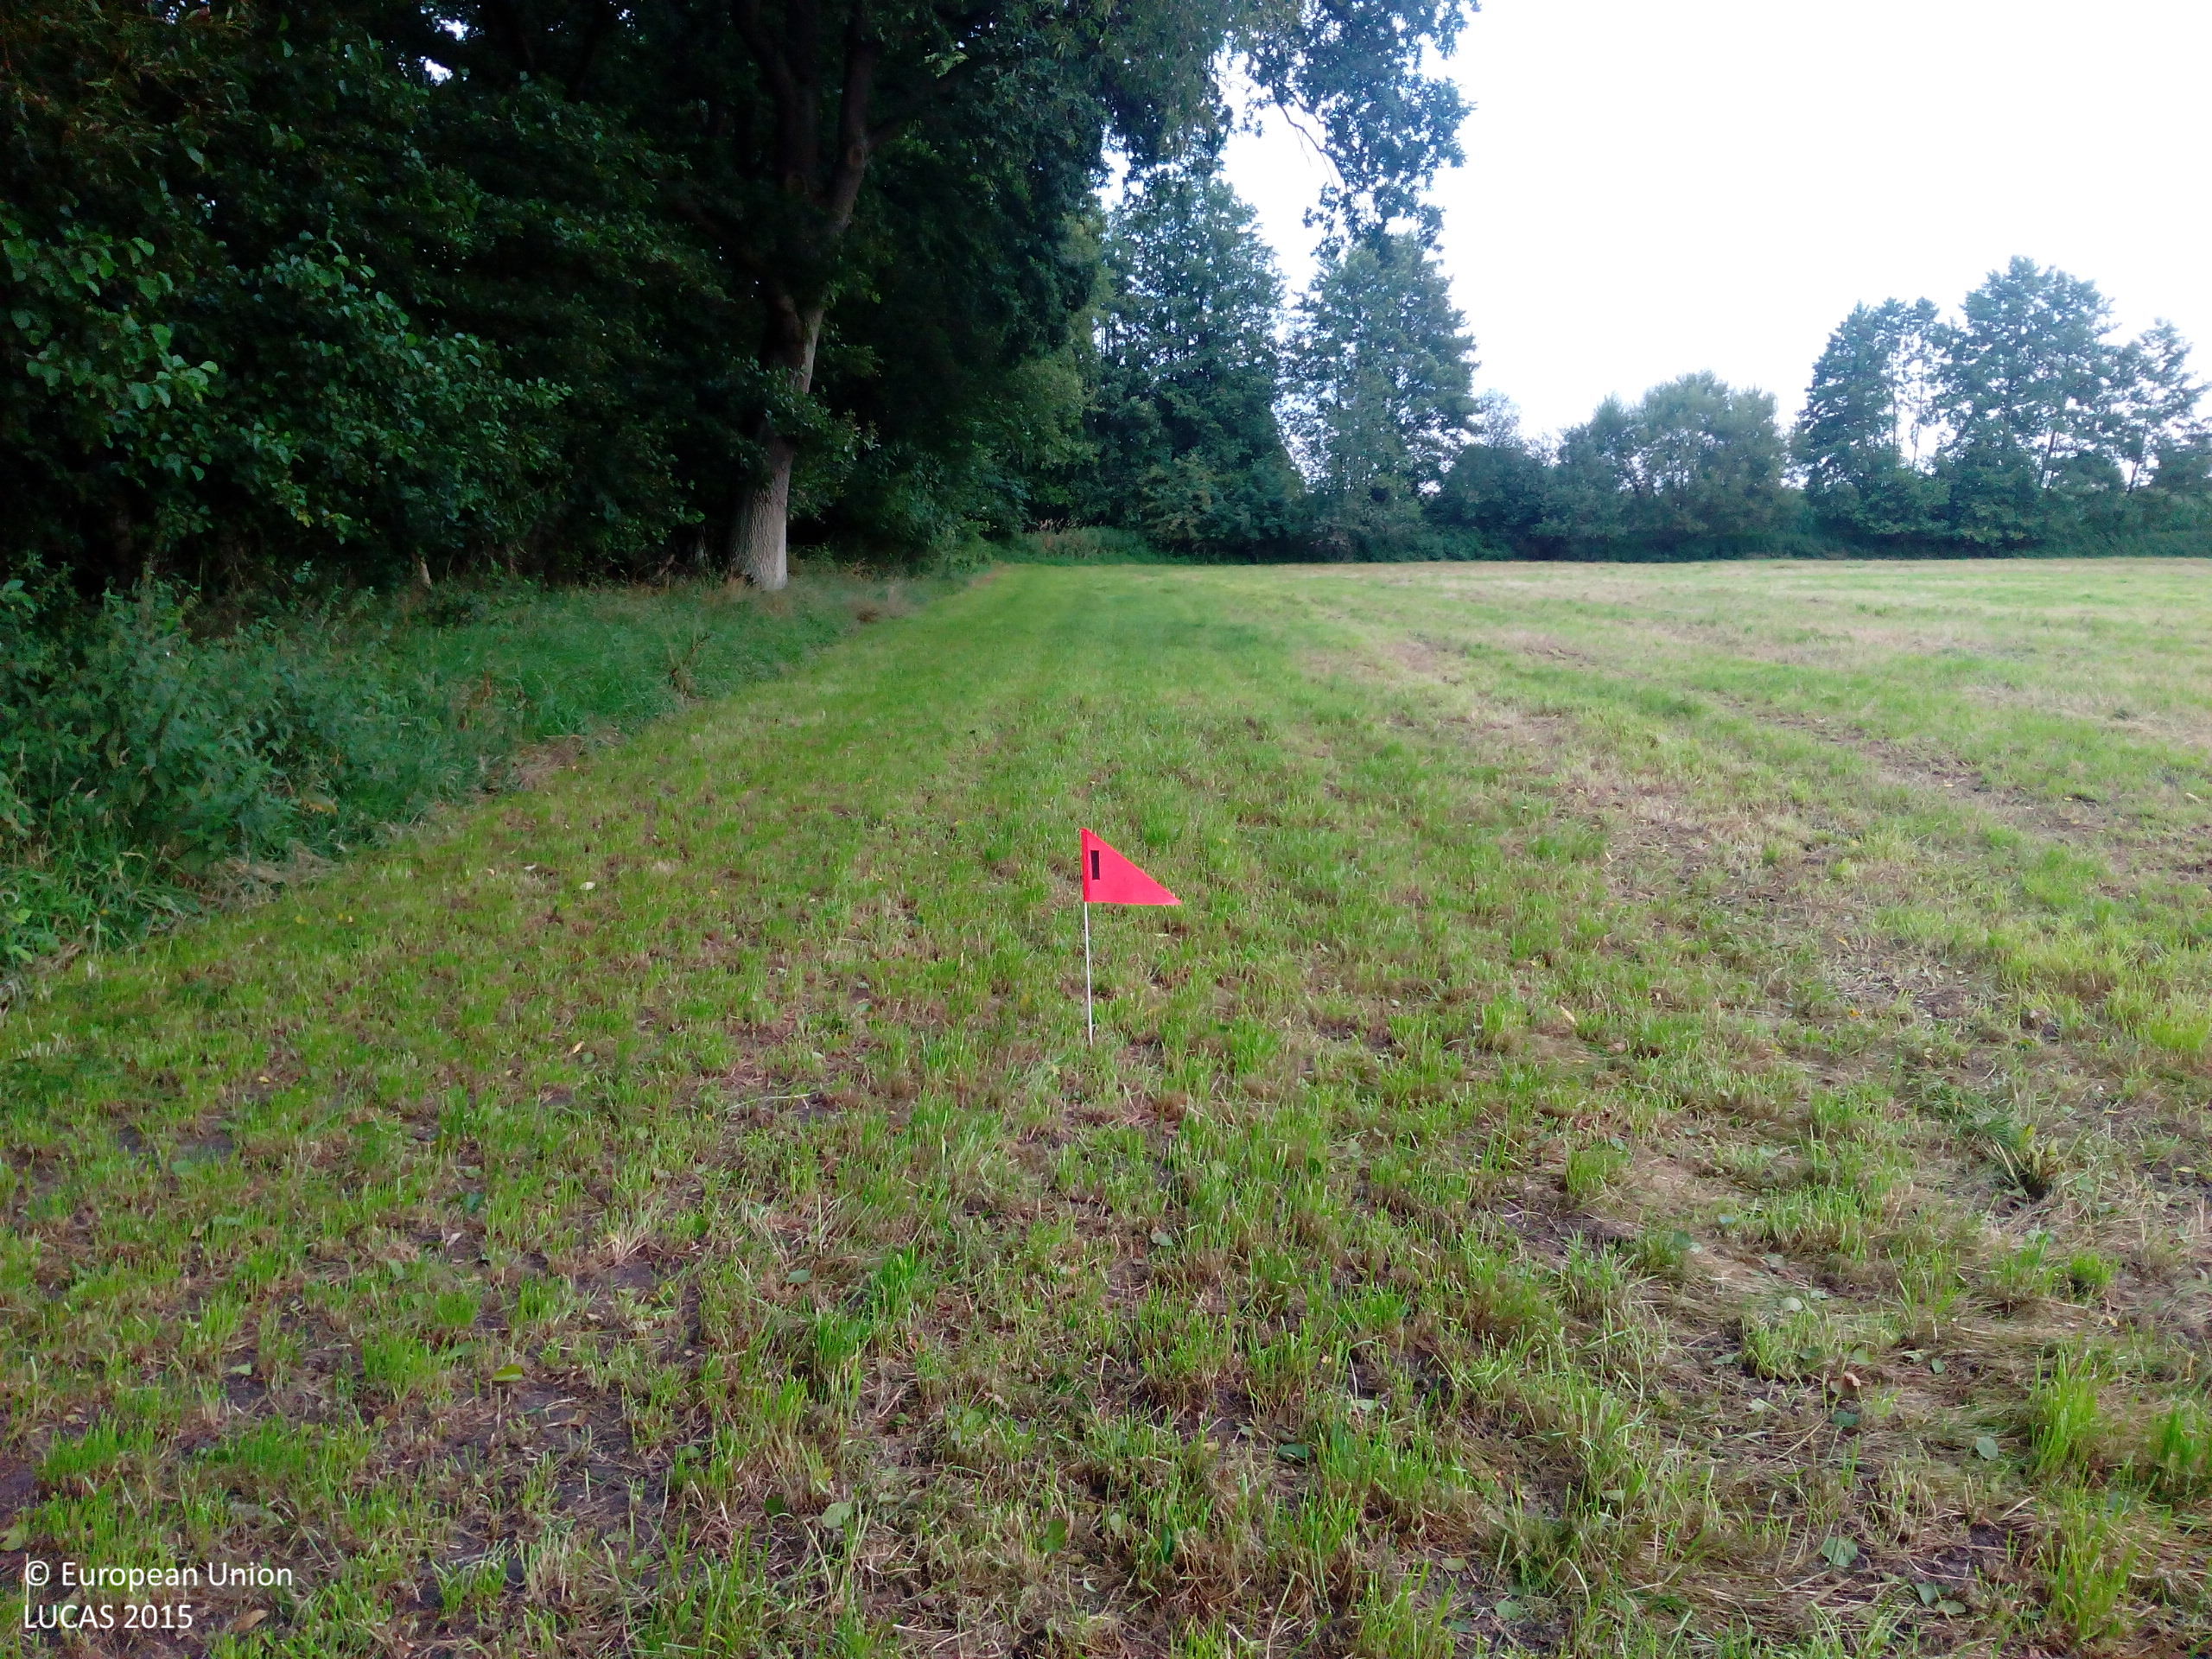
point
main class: Grassland
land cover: Grassland without tree/shrub cover
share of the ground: > 75 %
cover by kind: herbaceous plants 80 %, unconsolidated bare surface 20 %
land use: Agriculture (excluding fallow land and kitchen gardens)
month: August
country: DE
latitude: 53.8692
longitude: 9.9240
